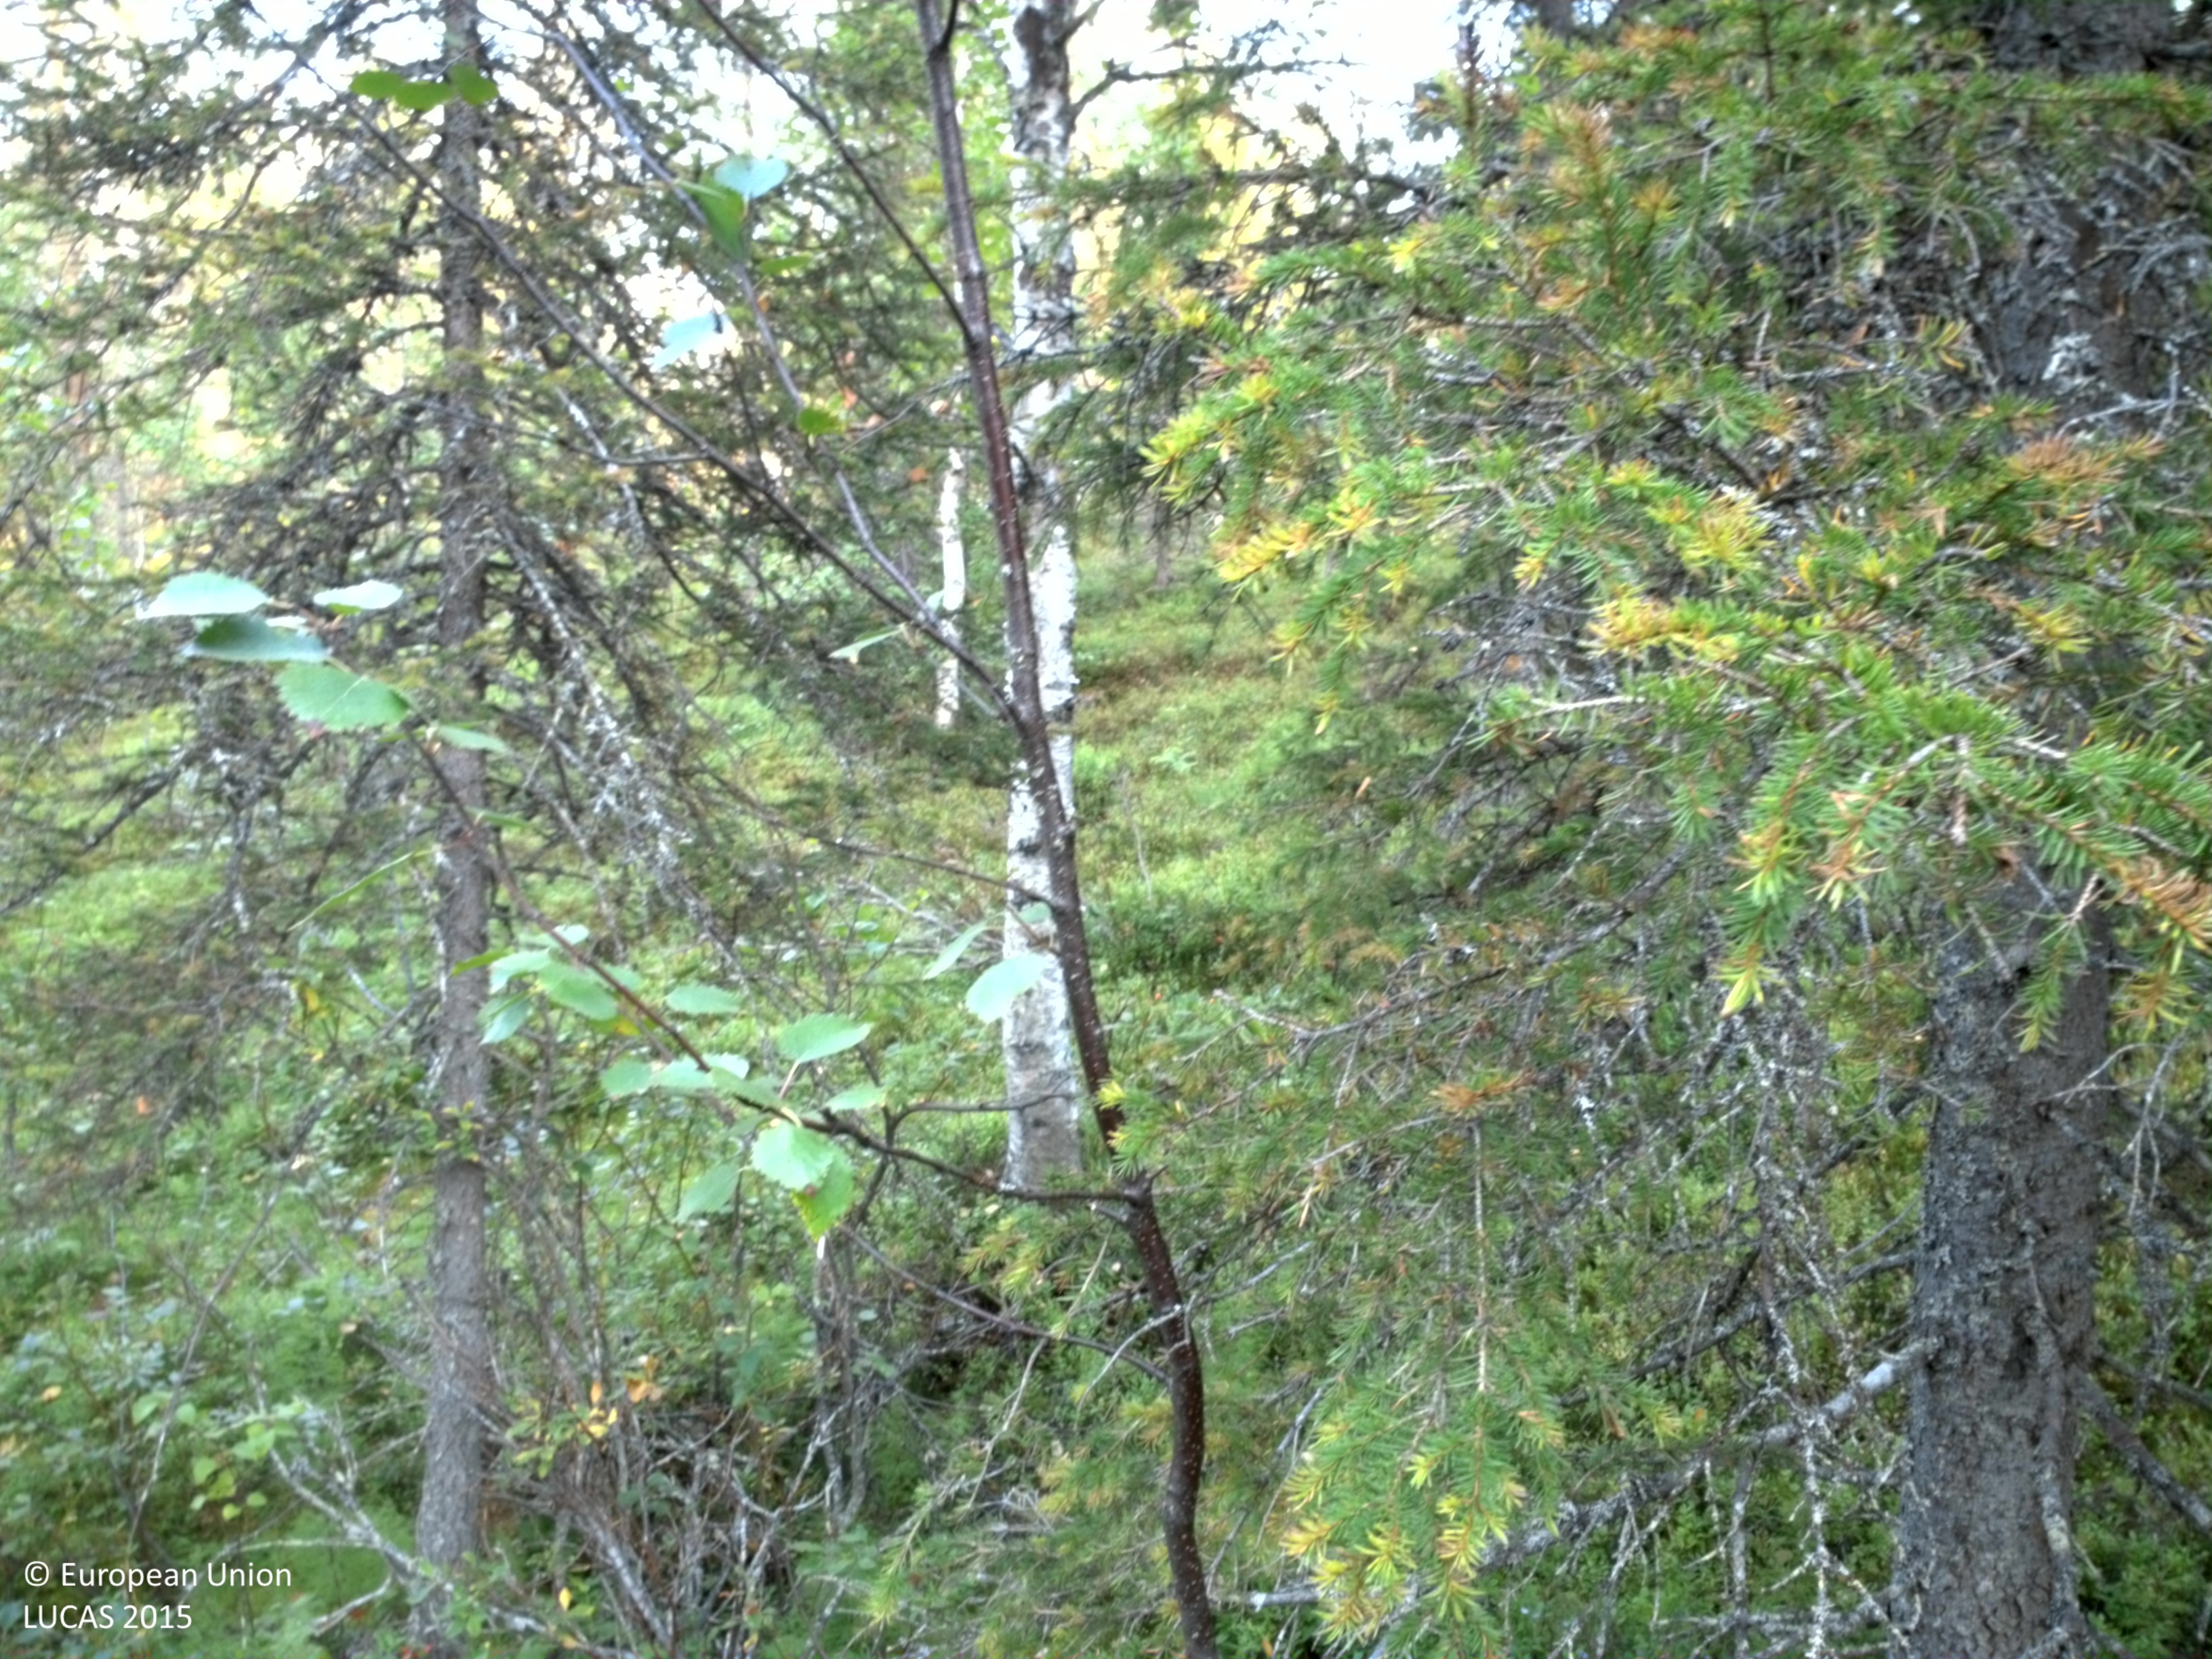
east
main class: Woodland
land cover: Spruce dominated mixed woodland
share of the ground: 25 - 50 %
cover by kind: shrubs 40 %, broadleaved forest trees 25 %, coniferous forest trees 20 %, lichens and mosses 10 %
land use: Forestry
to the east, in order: Spruce dominated mixed woodland; Pine dominated coniferous woodland; Shrubland without tree cover; Pine dominated coniferous woodland; Lichens and moss; Tracks; Pine dominated mixed woodland; Broadleaved woodland; Shrubland with sparse tree cover; Pine dominated coniferous woodland; Pine dominated mixed woodland
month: August
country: SE
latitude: 66.6086
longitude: 20.7685
